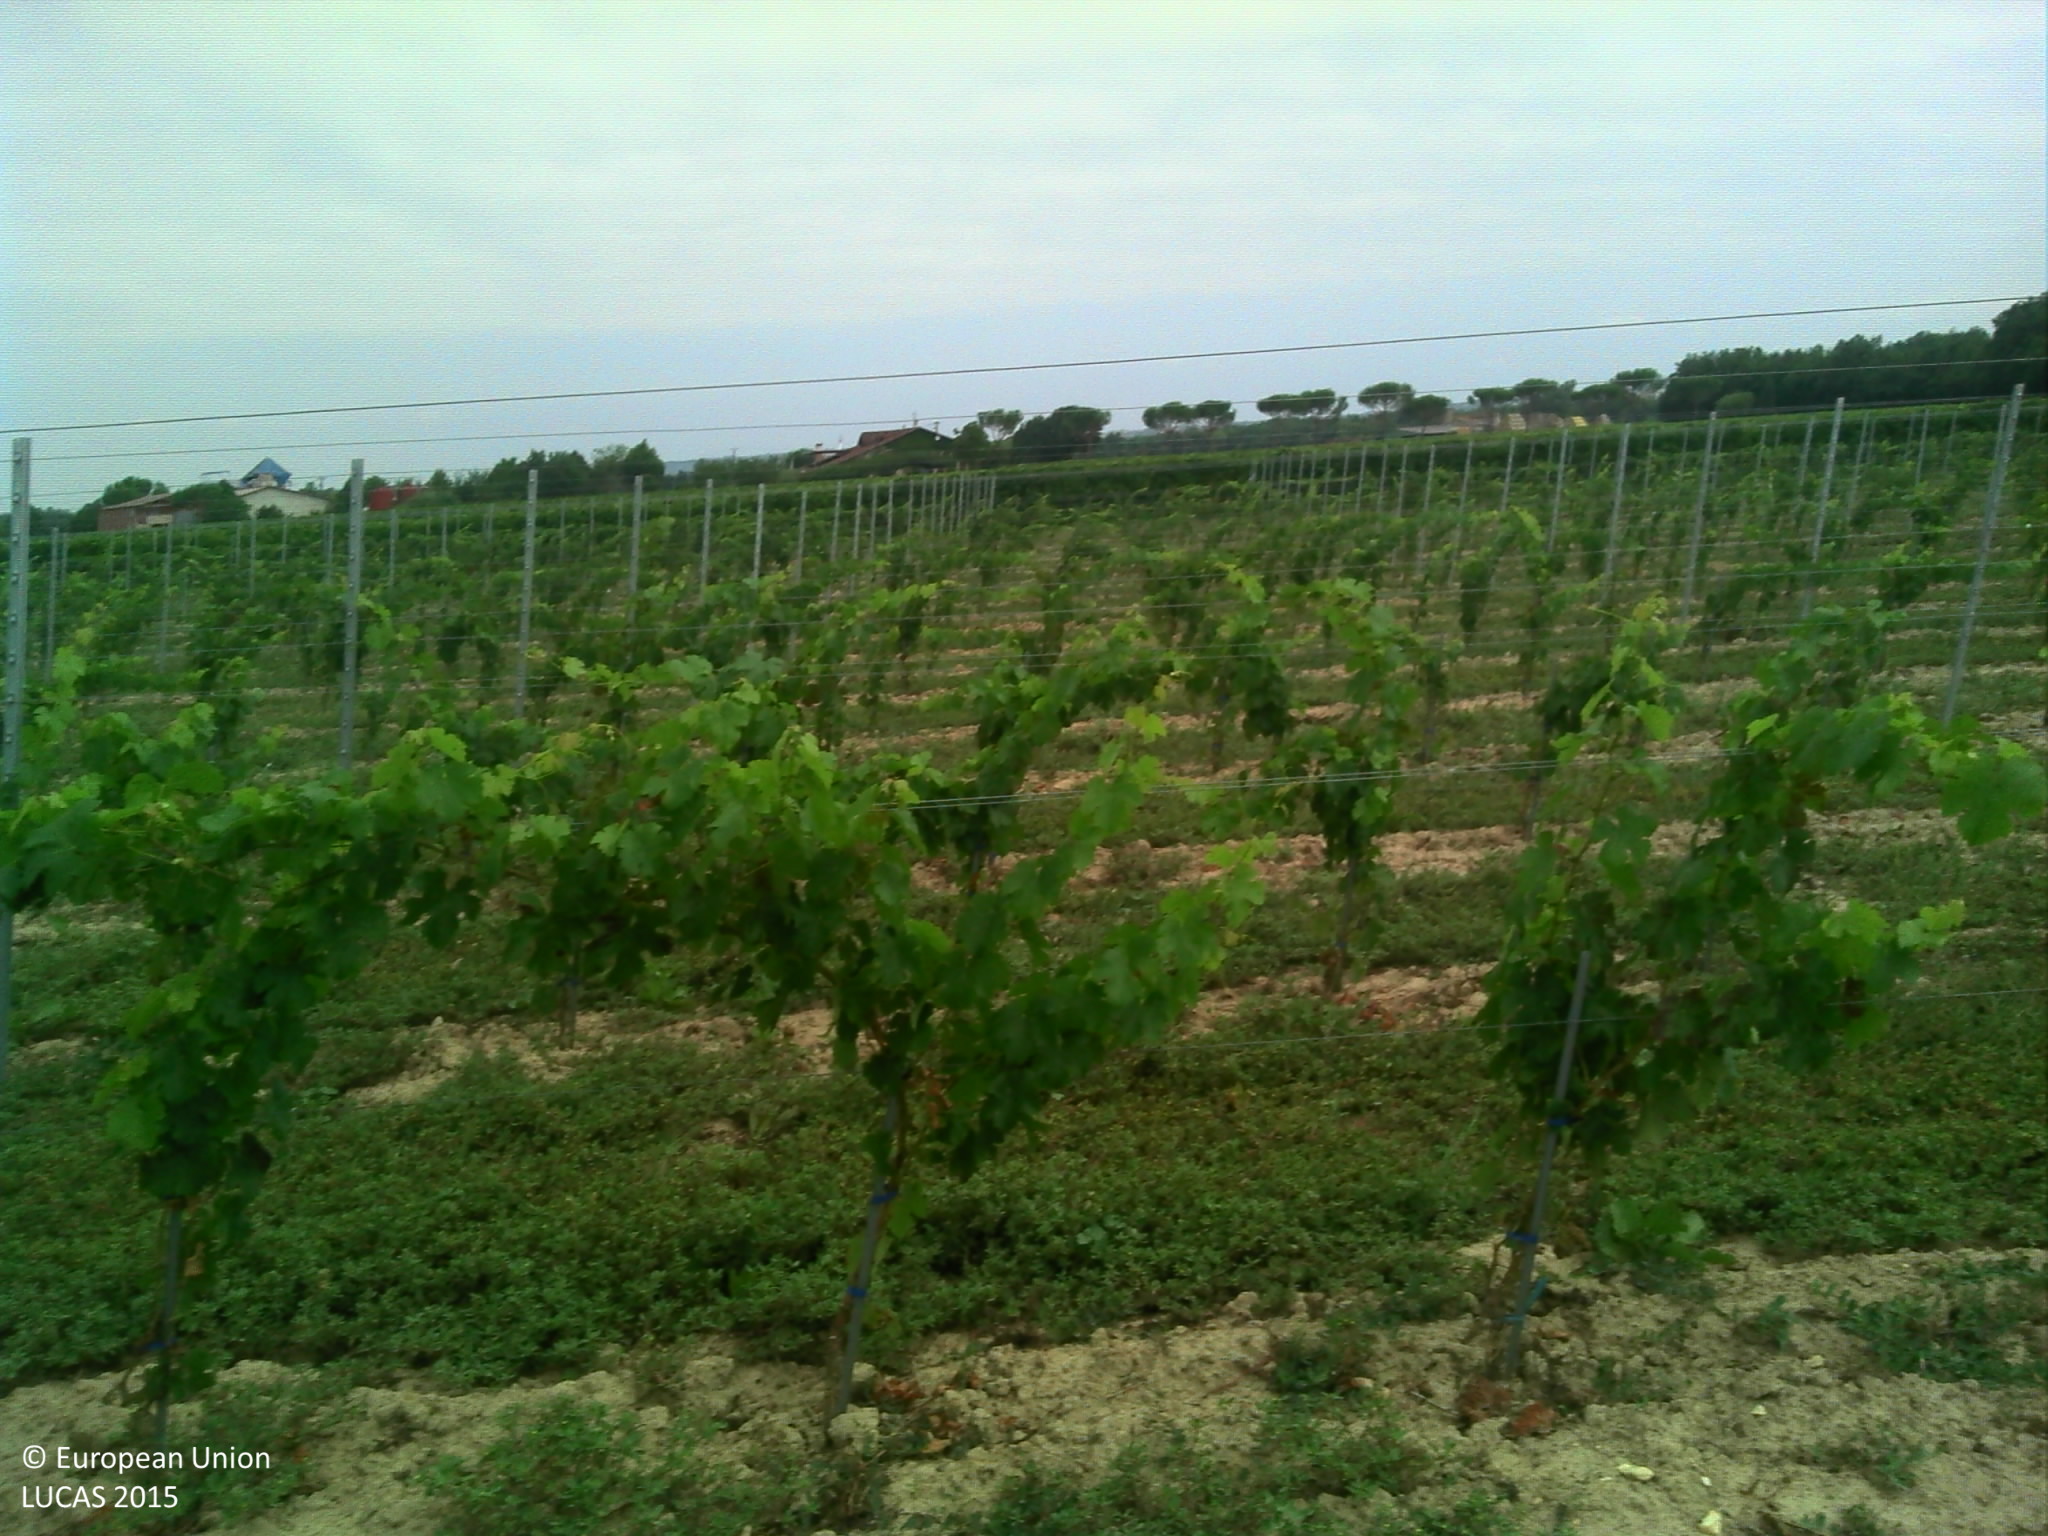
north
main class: Cropland
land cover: Vineyards
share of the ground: 25 - 50 %
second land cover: Spontaneously vegetated surfaces
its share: > 75 %
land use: Agriculture (excluding fallow land and kitchen gardens)
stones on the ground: < 10 %
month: August
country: FR
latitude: 43.8980
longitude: 1.3481
